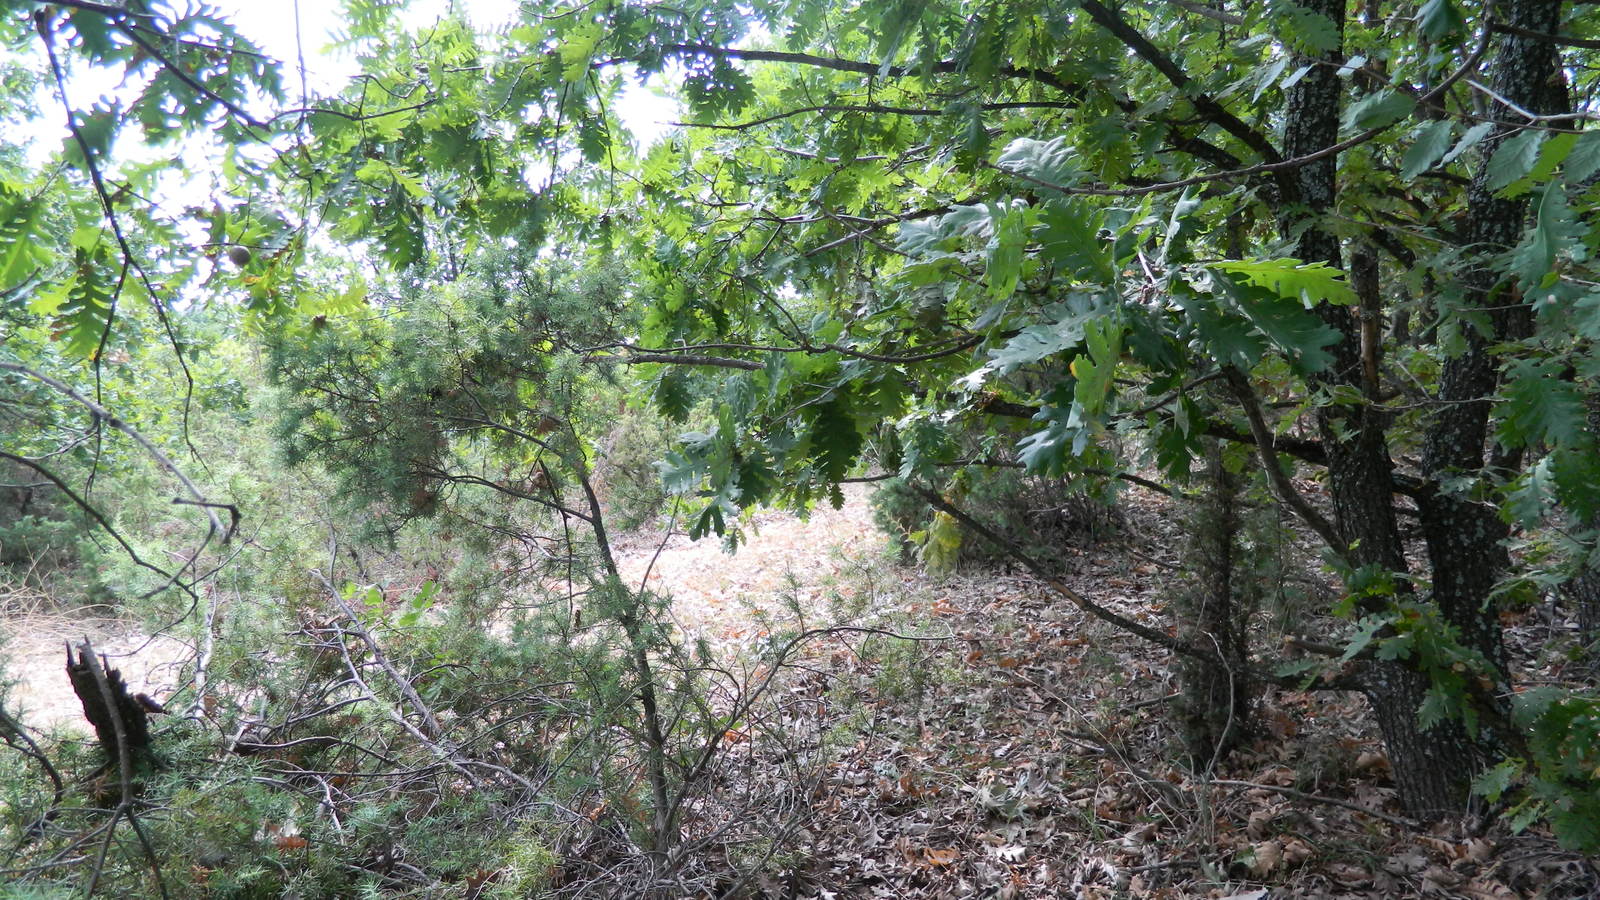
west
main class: Woodland
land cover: Broadleaved woodland
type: mesophytic deciduous forest
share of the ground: > 75 %
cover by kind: broadleaved forest trees 80 %, unconsolidated bare surface 15 %, shrubs 5 %
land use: Forestry
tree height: > 5 m
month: August
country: BG
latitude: 41.6956
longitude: 25.8192
